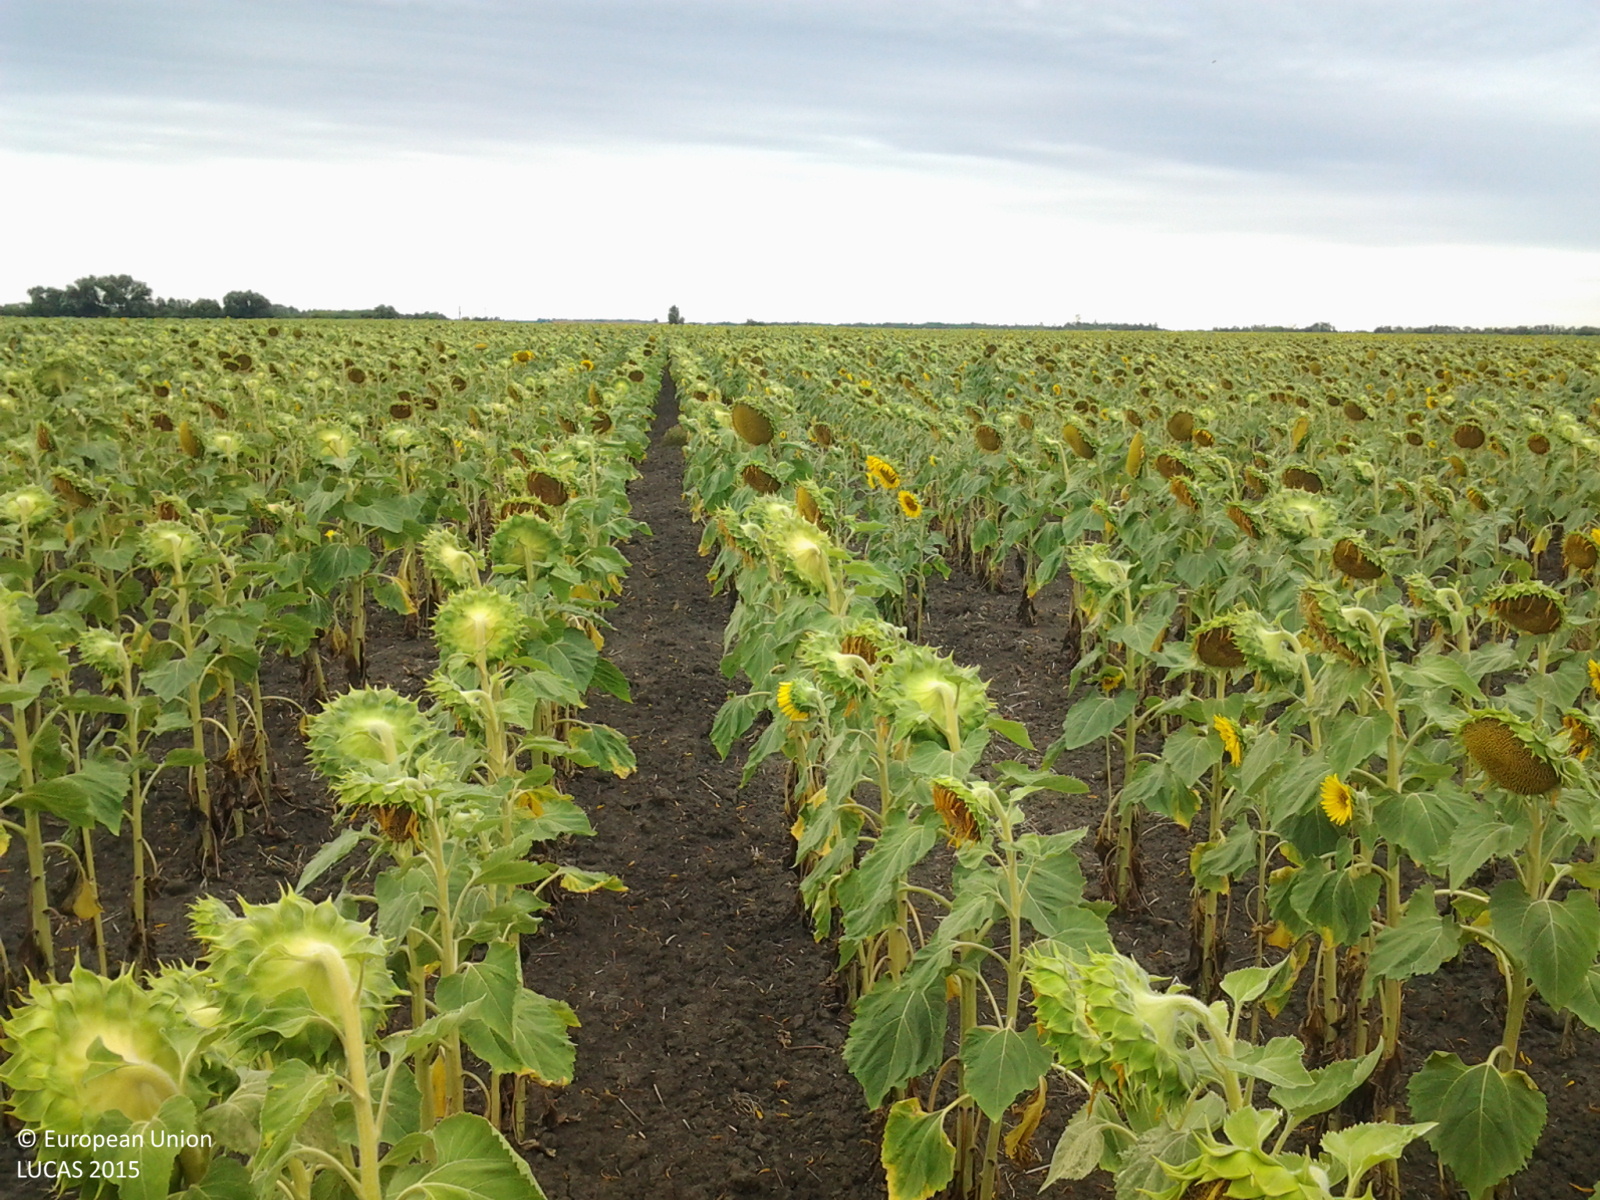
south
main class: Cropland
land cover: Sunflower
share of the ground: > 75 %
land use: Agriculture (excluding fallow land and kitchen gardens)
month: July
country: HU
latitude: 47.1363
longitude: 20.5380
